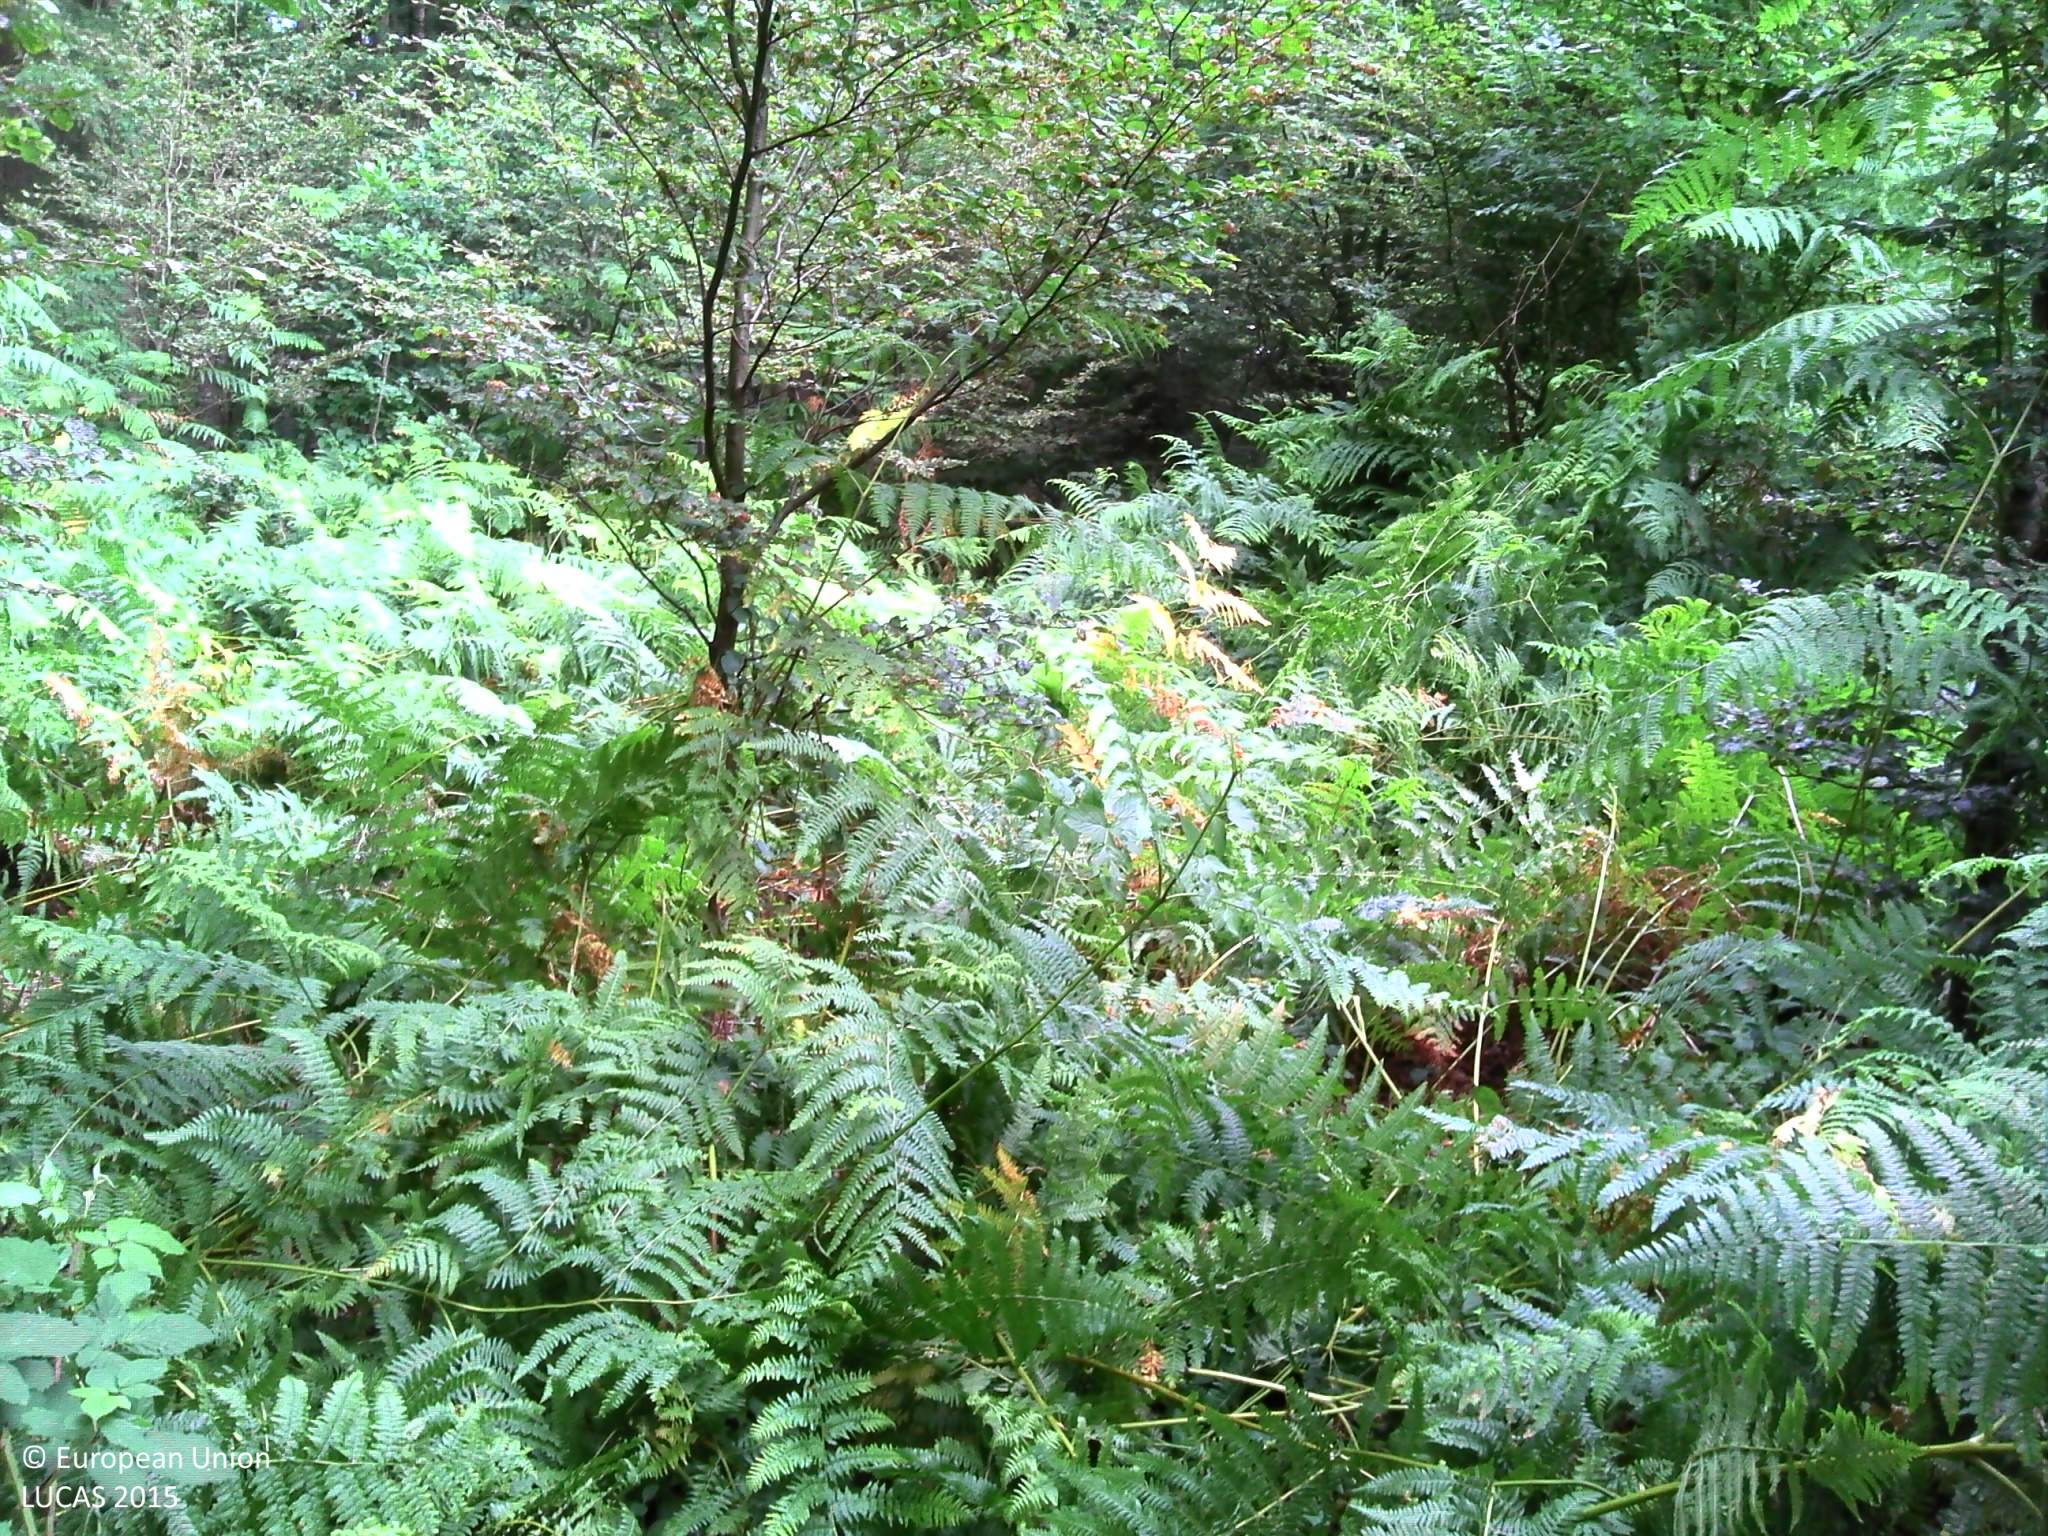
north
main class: Woodland
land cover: Broadleaved woodland
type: beech forest
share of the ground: 50 - 75 %
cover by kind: broadleaved forest trees 70 %, herbaceous plants 30 %
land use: Forestry
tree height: > 5 m
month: July
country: BE
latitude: 49.6146
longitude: 5.6390
